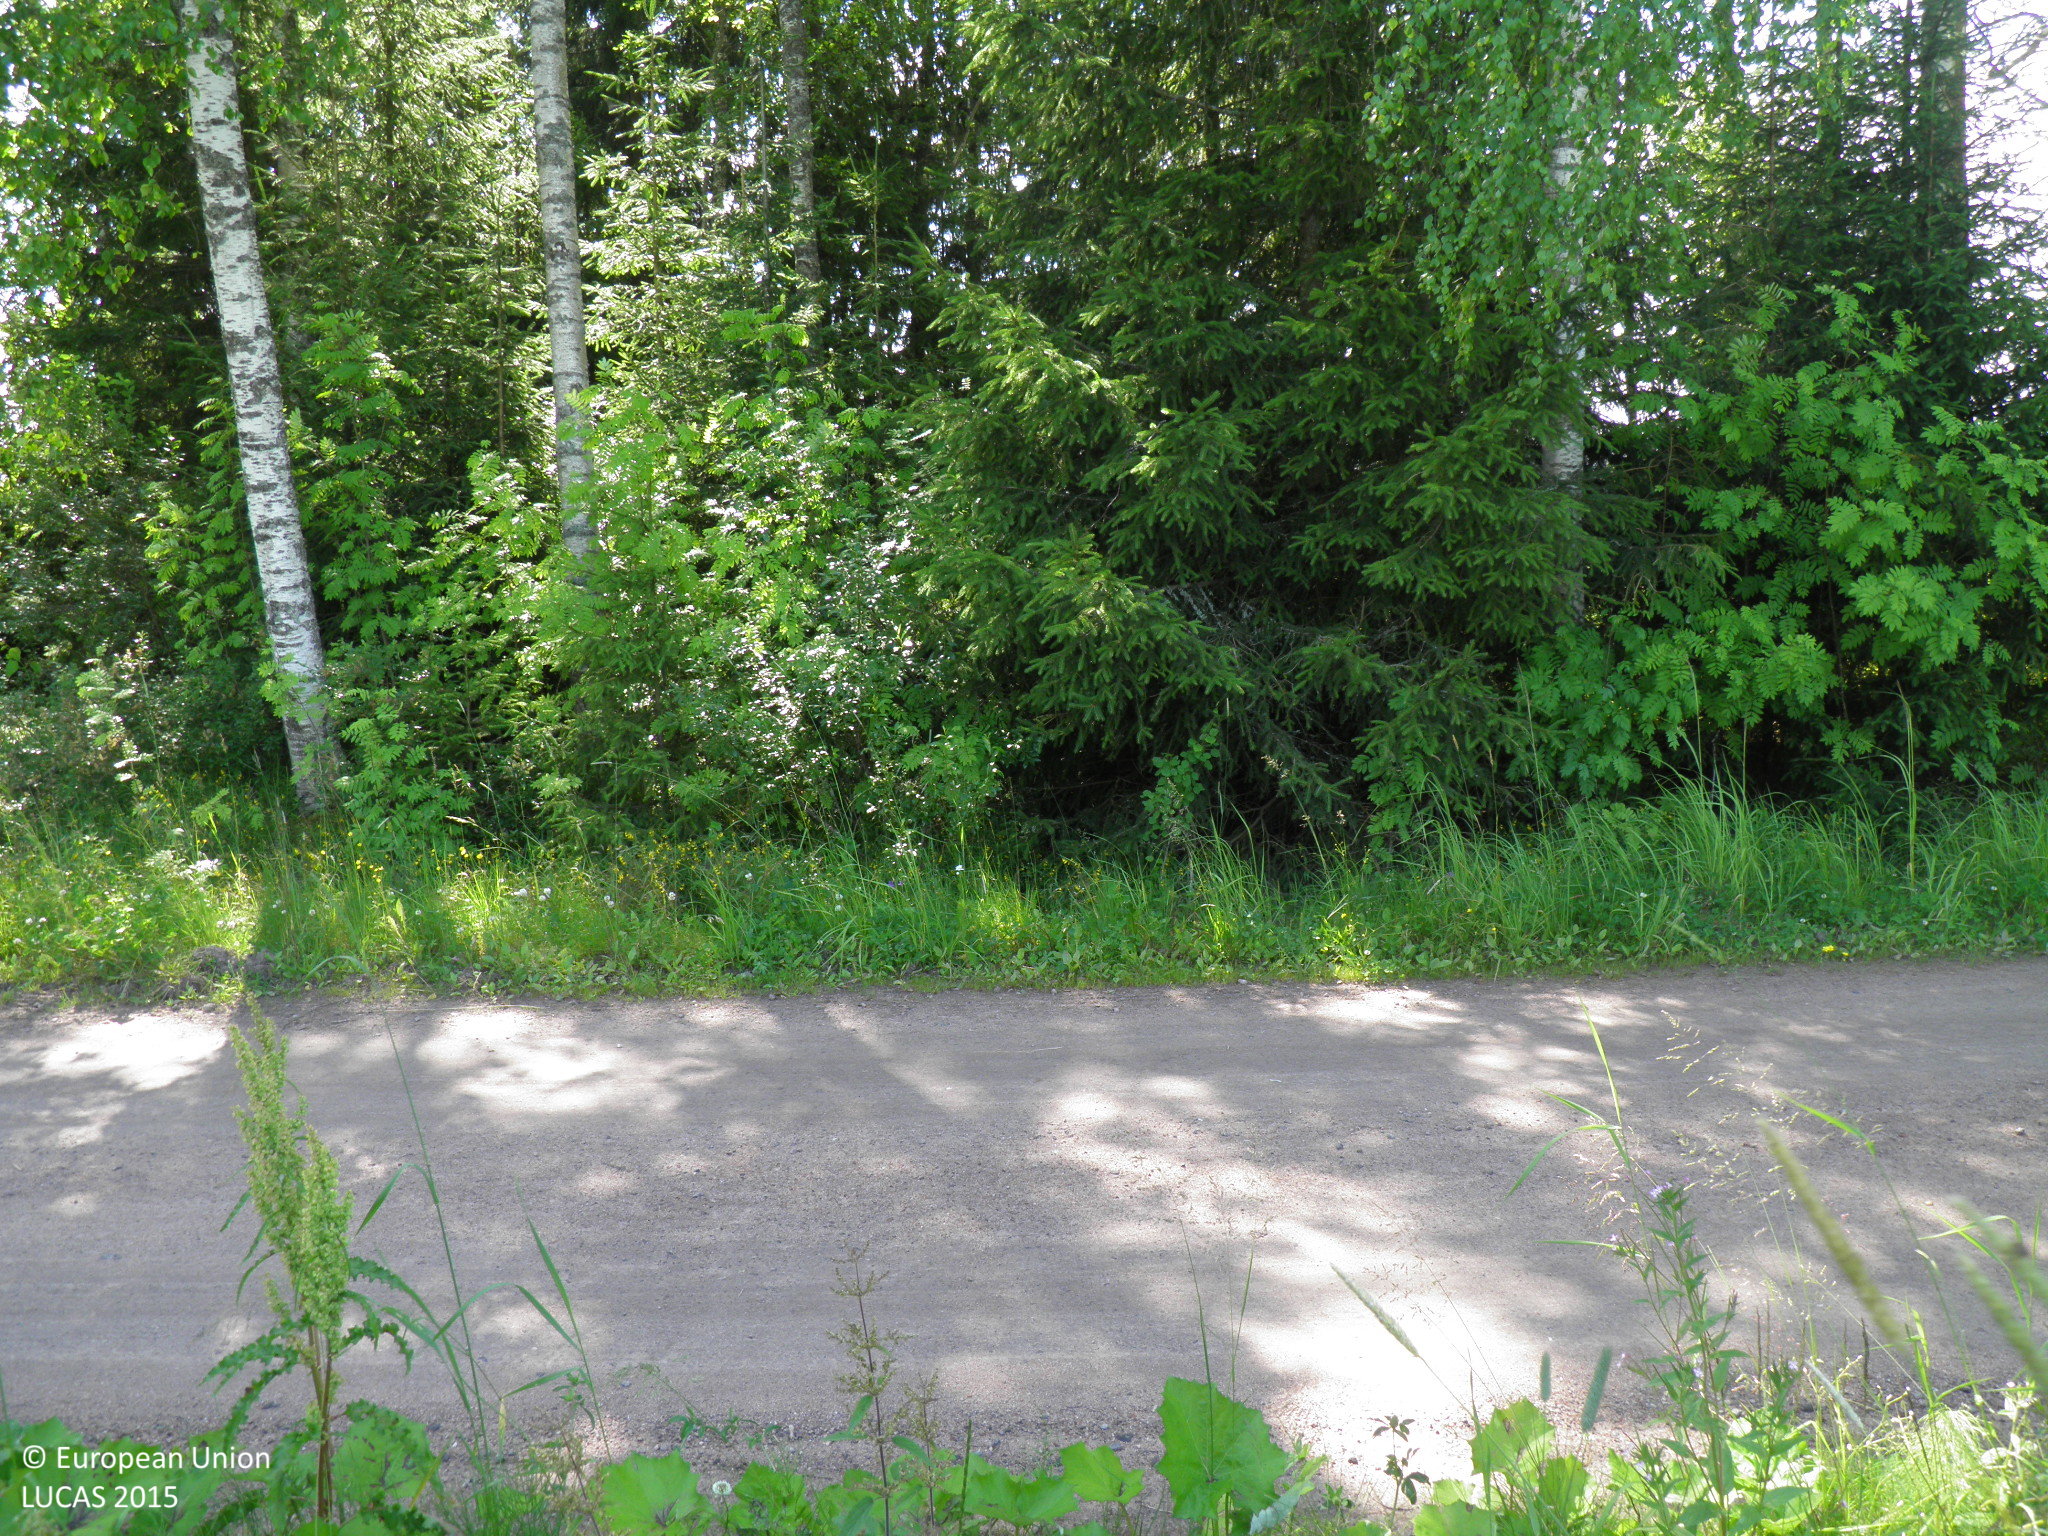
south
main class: Cropland
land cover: Common wheat
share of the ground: > 75 %
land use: Agriculture (excluding fallow land and kitchen gardens)
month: July
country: FI
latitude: 60.9205
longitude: 22.4805
